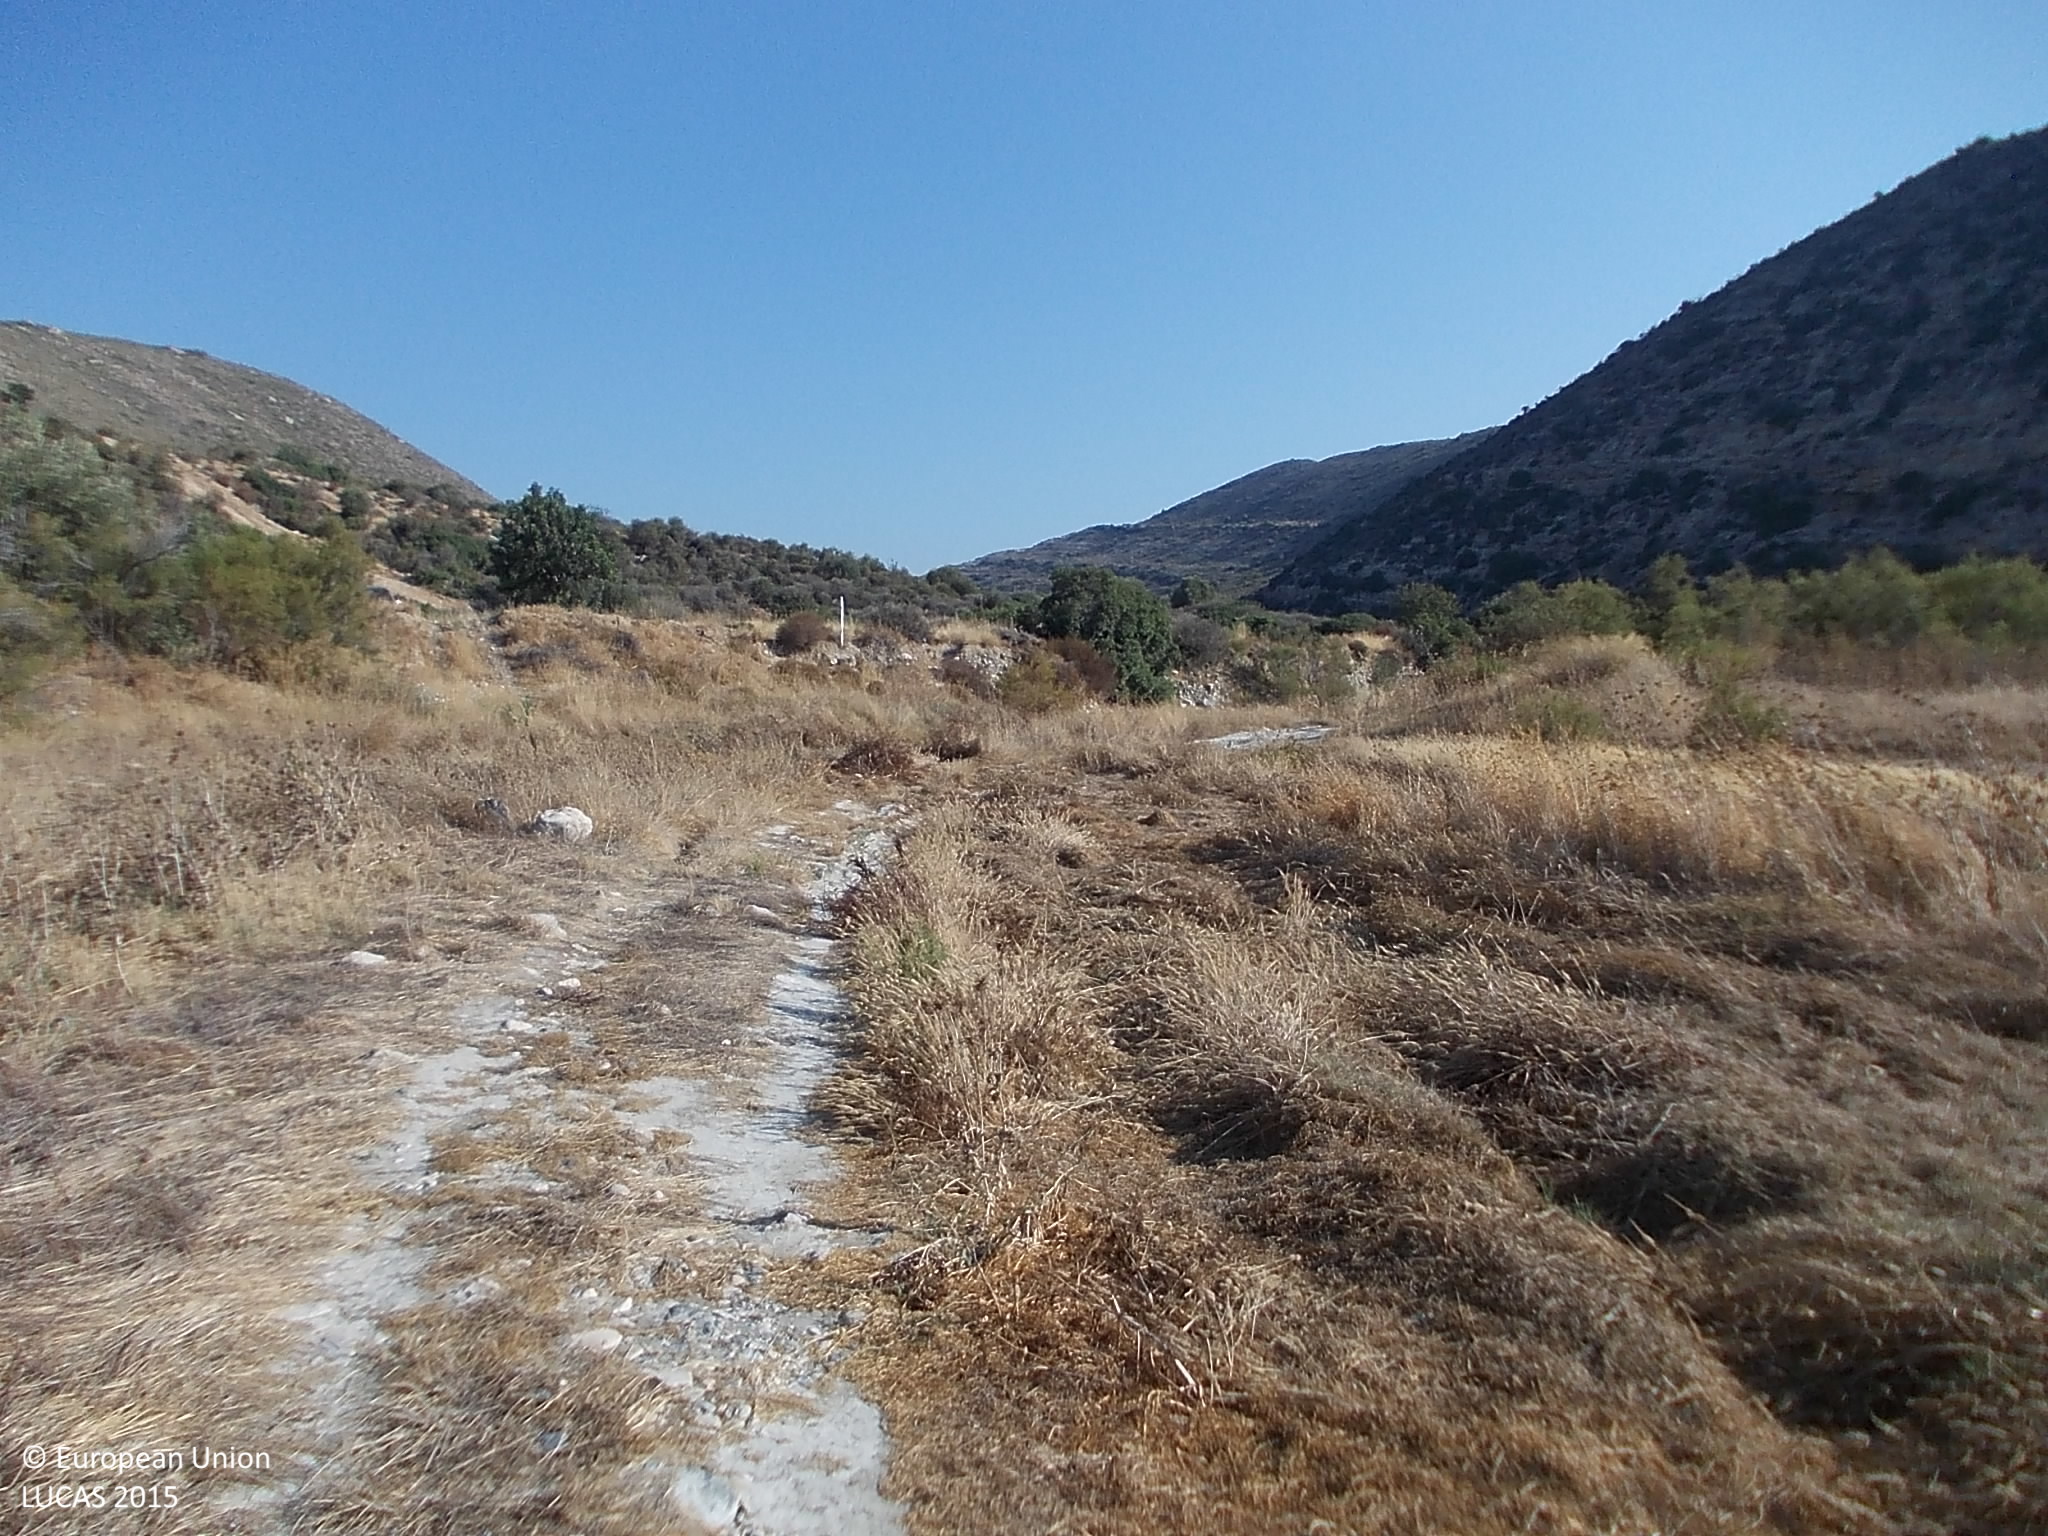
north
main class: Shrubland
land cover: Shrubland without tree cover
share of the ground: > 75 %
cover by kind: shrubs 85 %, herbaceous plants 10 %
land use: Semi-natural and natural areas not in use
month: August
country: CY
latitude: 34.7250
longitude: 32.9763
